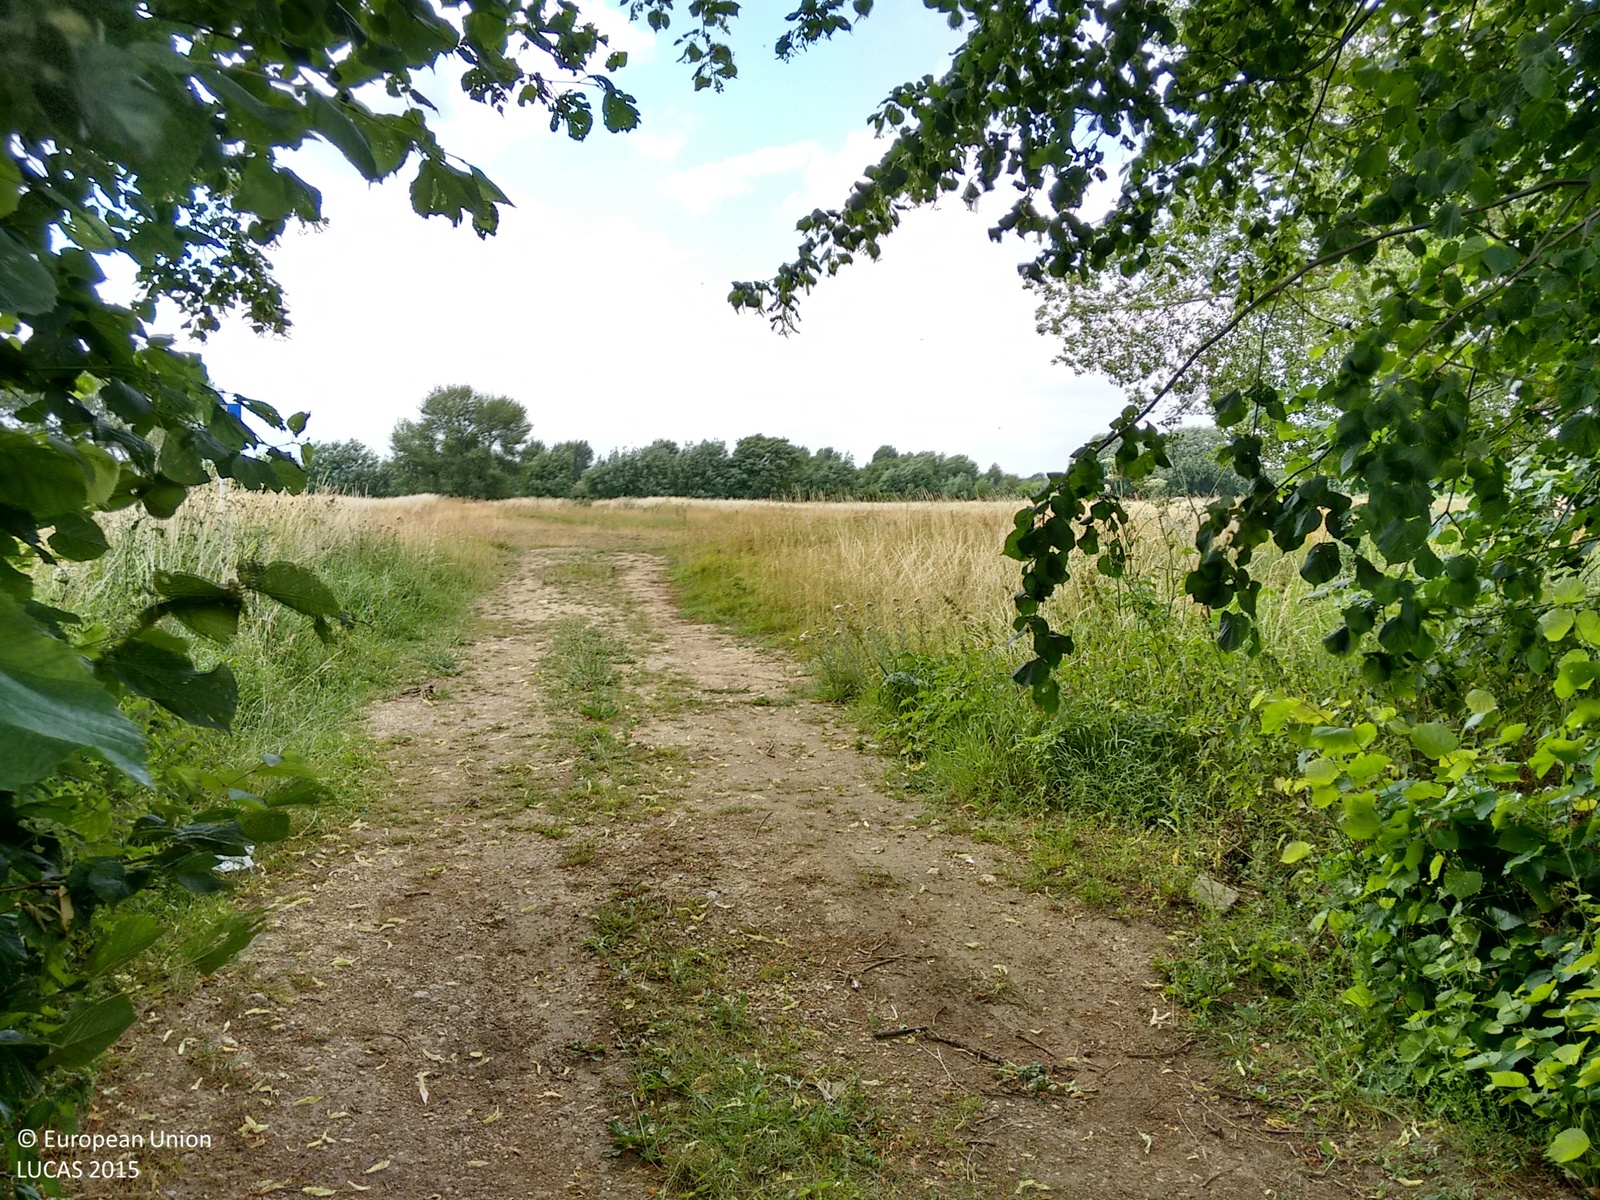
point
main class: Grassland
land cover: Grassland with sparse tree/shrub cover
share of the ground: > 75 %
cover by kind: herbaceous plants 95 %, broadleaved forest trees 5 %
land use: Agriculture (excluding fallow land and kitchen gardens)
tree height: > 5 m
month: July
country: GB
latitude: 51.7328
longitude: -1.2403
